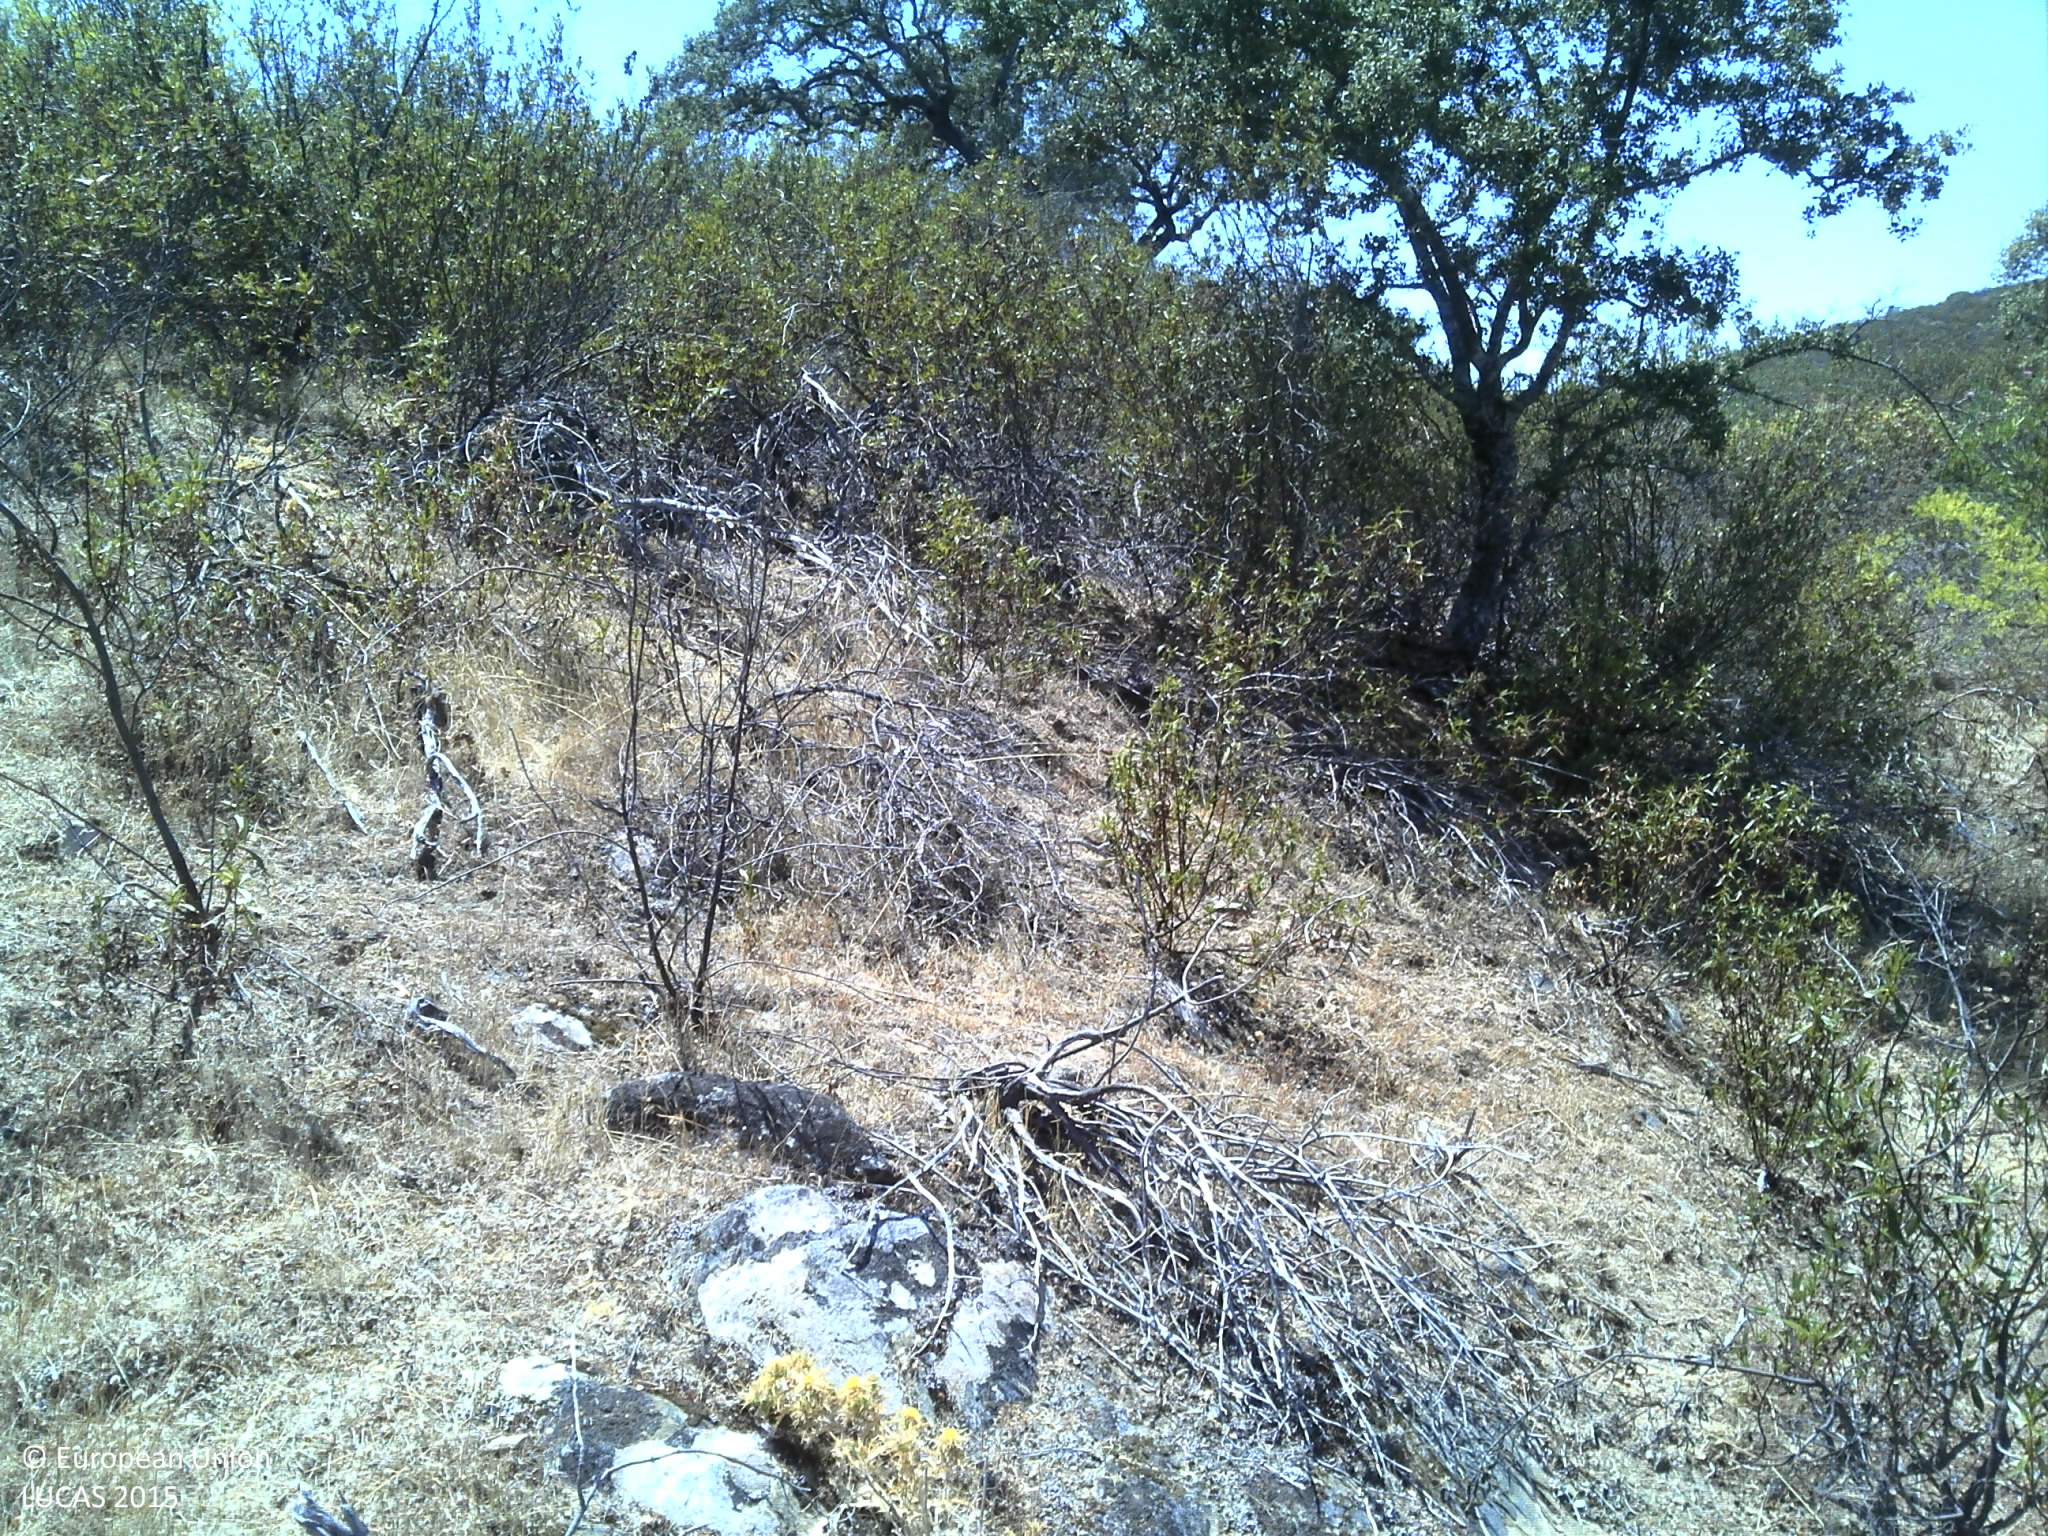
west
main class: Shrubland
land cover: Shrubland with sparse tree cover
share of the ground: 50 - 75 %
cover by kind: shrubs 65 %, herbaceous plants 20 %, unconsolidated bare surface 10 %, broadleaved forest trees 5 %
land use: Abandoned areas
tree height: < 5 m
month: July
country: PT
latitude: 37.5843
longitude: -7.9241
